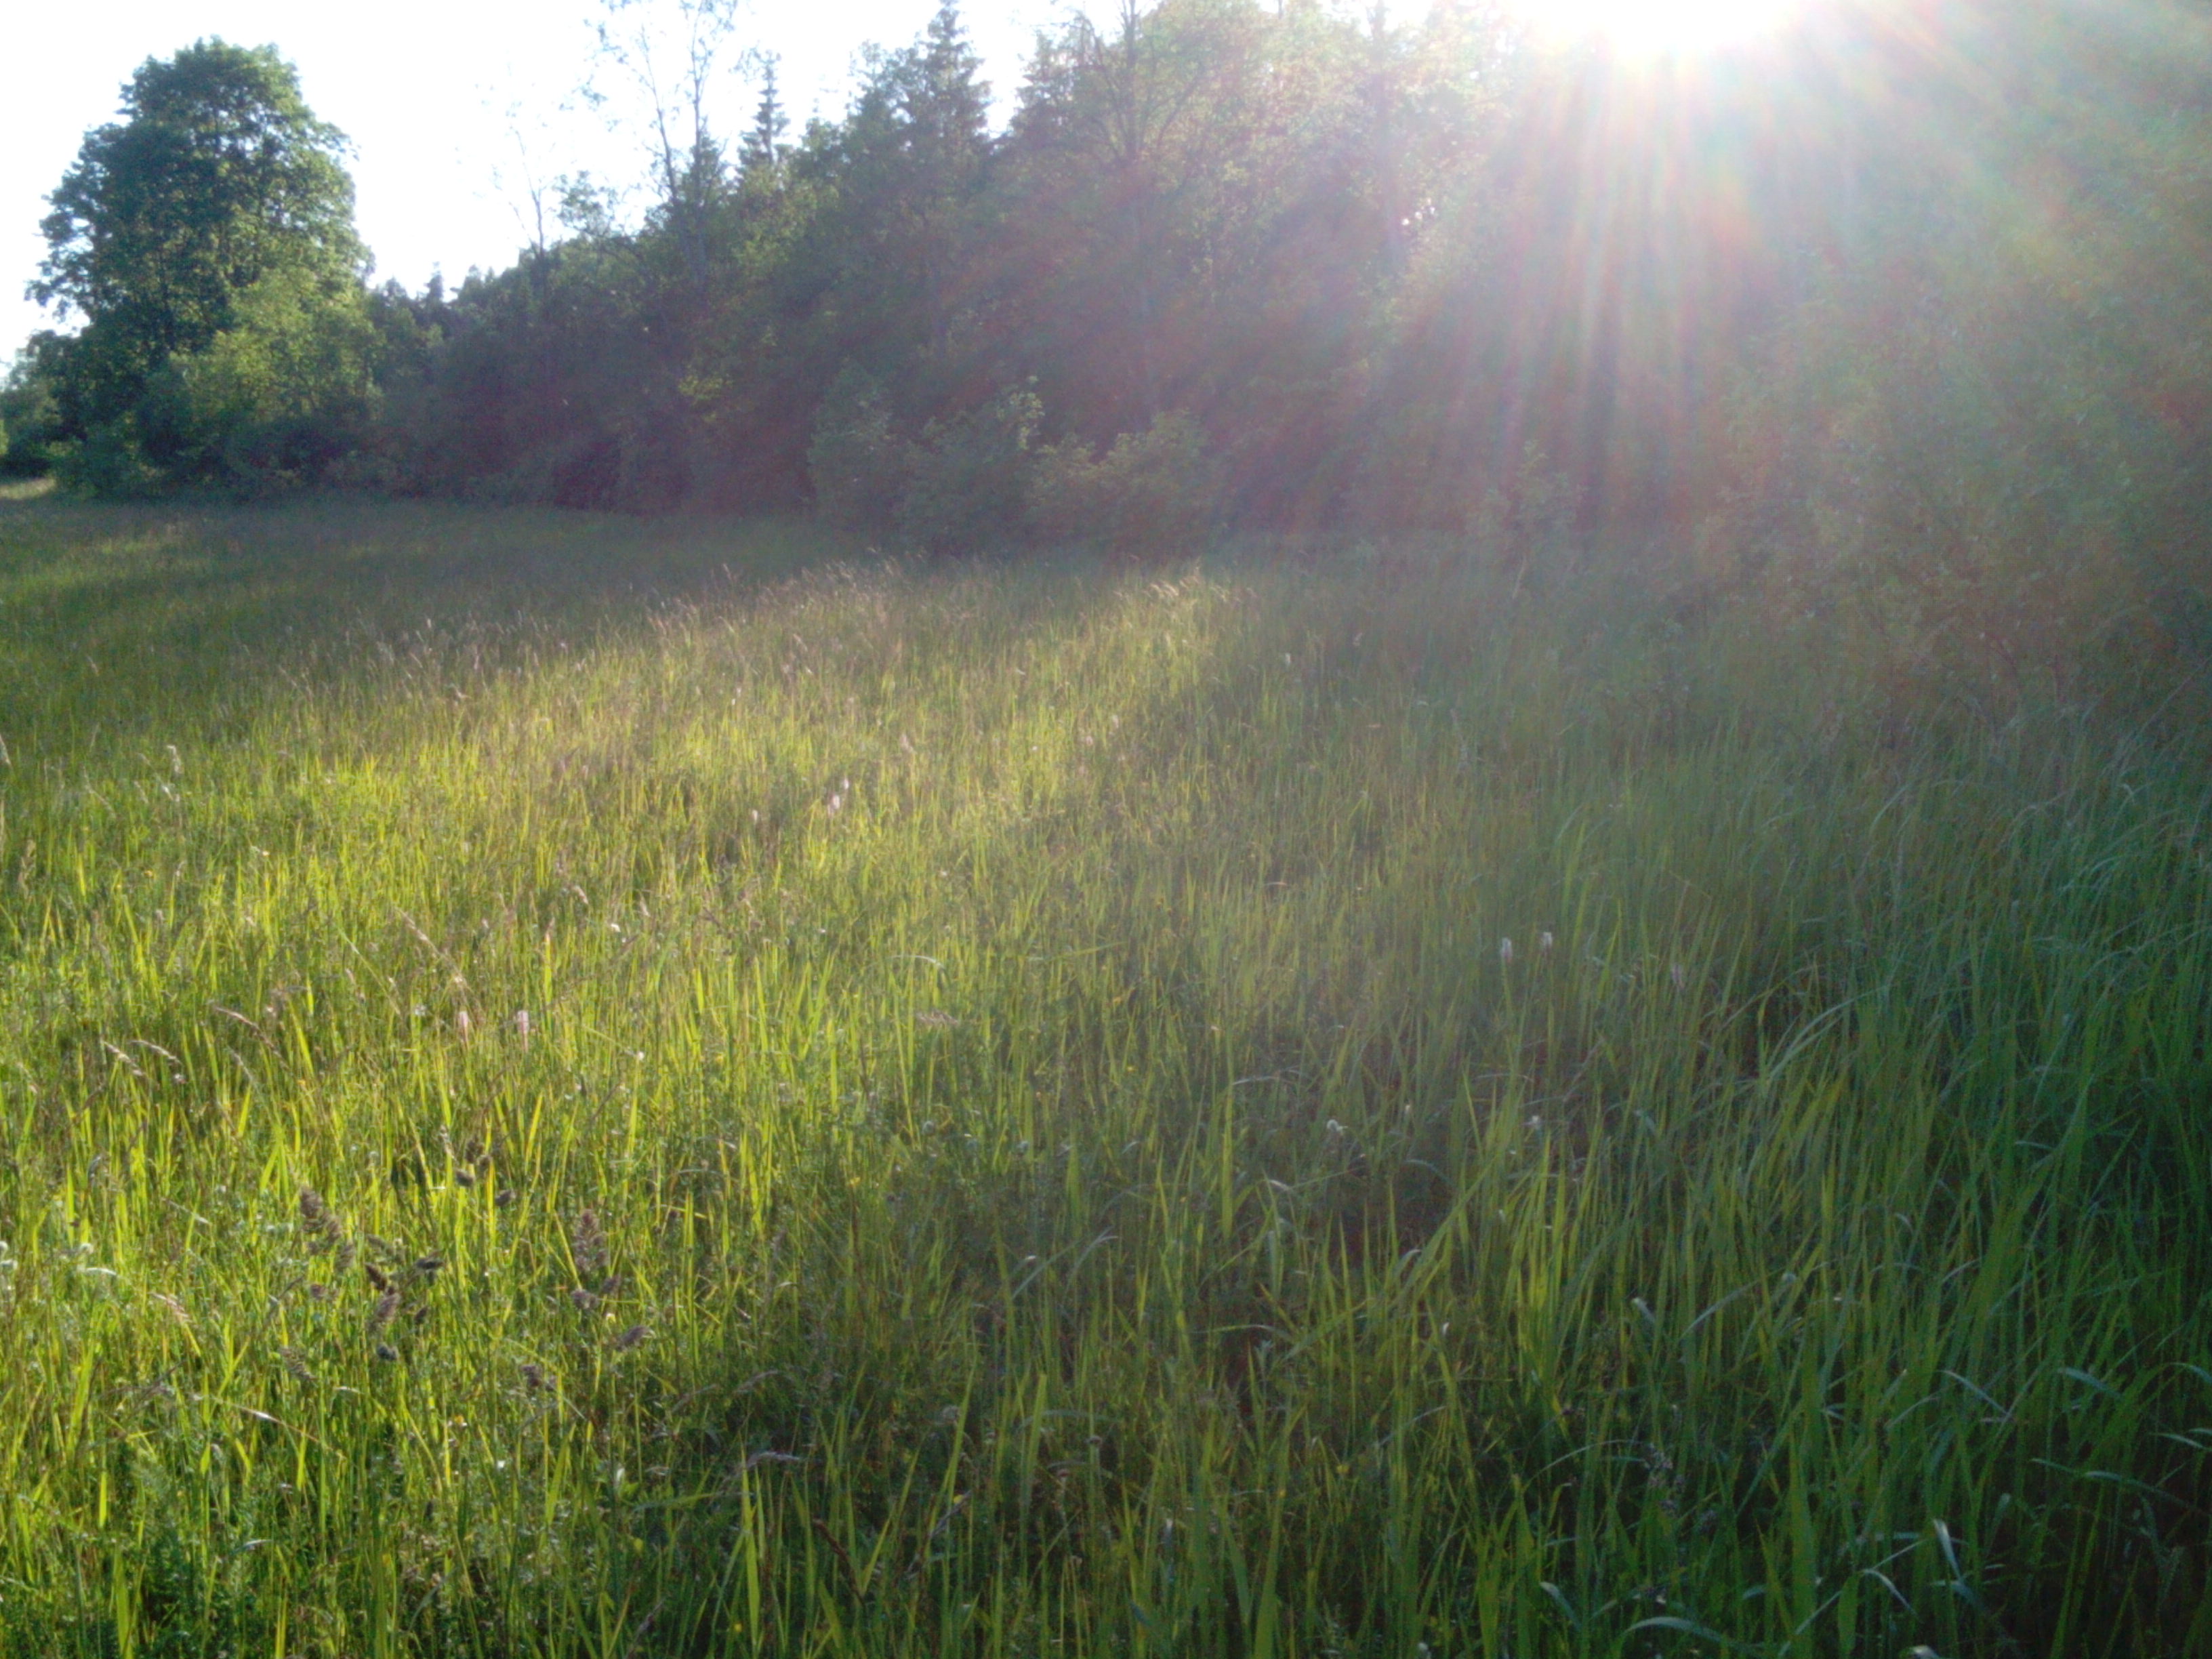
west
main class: Grassland
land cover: Grassland without tree/shrub cover
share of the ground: > 75 %
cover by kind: herbaceous plants 100 %
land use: Agriculture (excluding fallow land and kitchen gardens)
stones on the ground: < 10 %
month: June
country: LV
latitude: 56.6854
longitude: 22.1146
